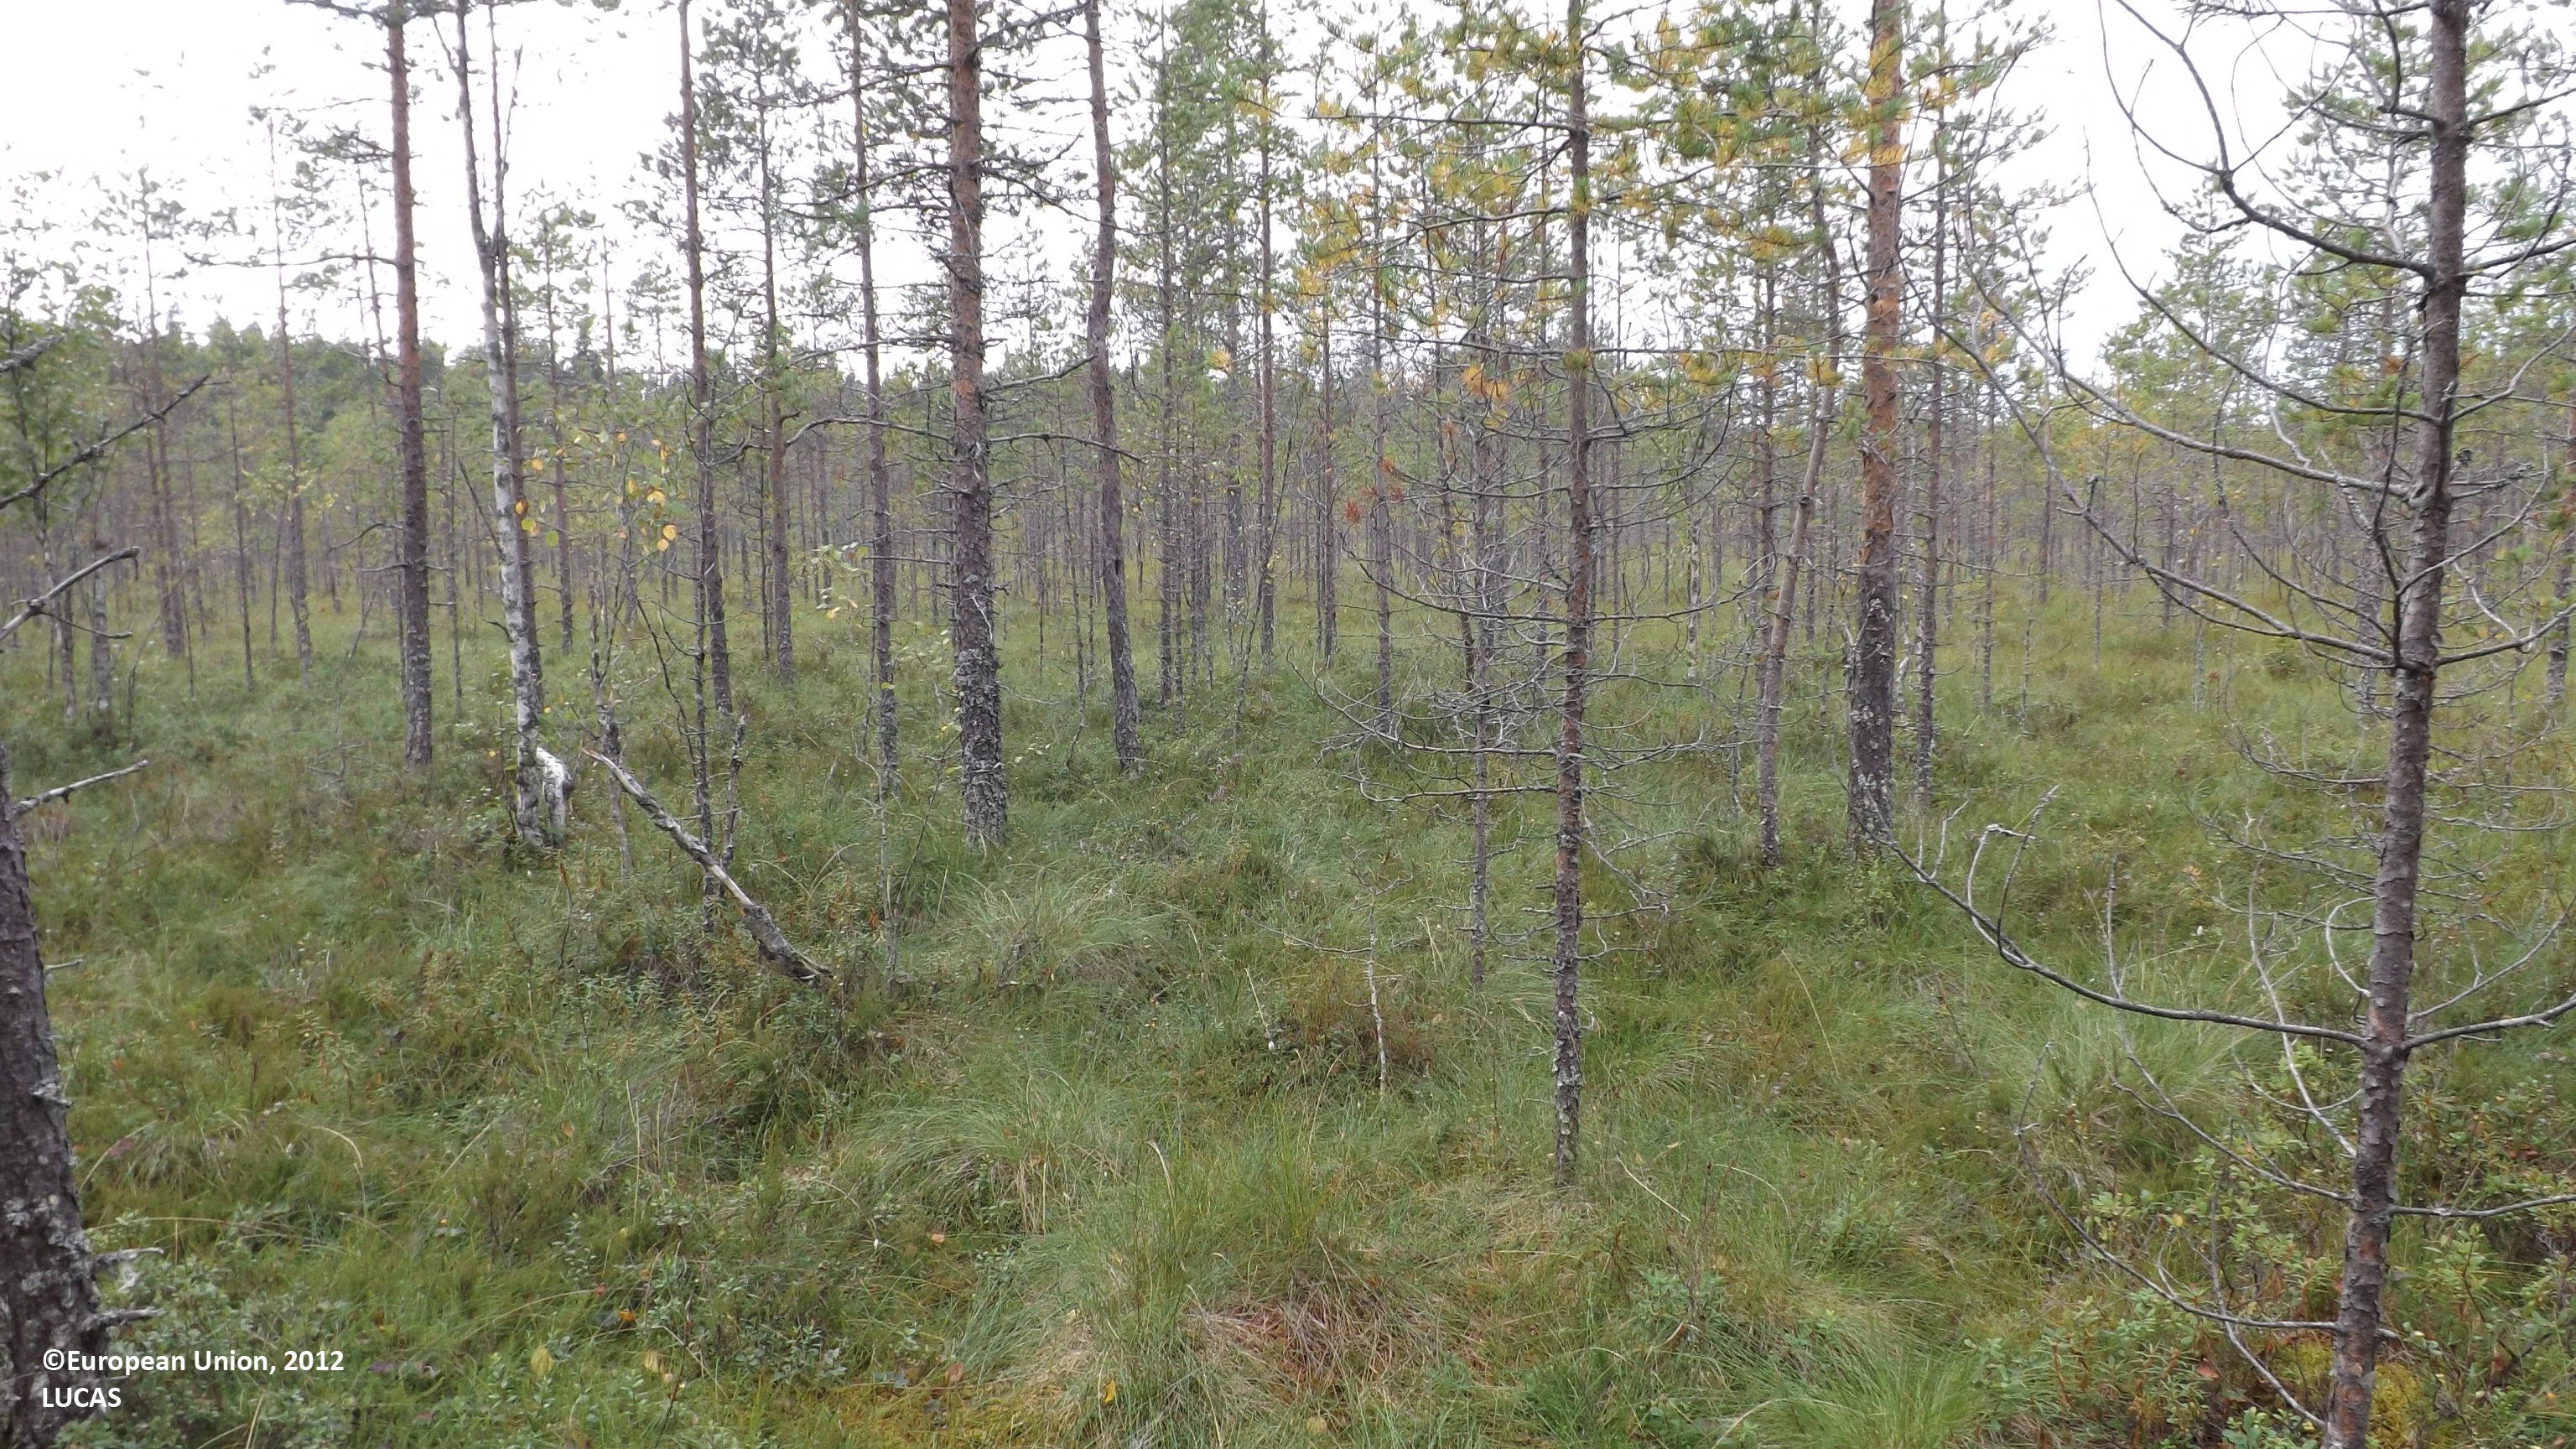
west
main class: Woodland
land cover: Pine dominated mixed woodland
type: mire and swamp forests
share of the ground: 25 - 50 %
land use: Semi-natural and natural areas not in use
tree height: > 5 m
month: August
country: FI
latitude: 63.7030
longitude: 23.9669
